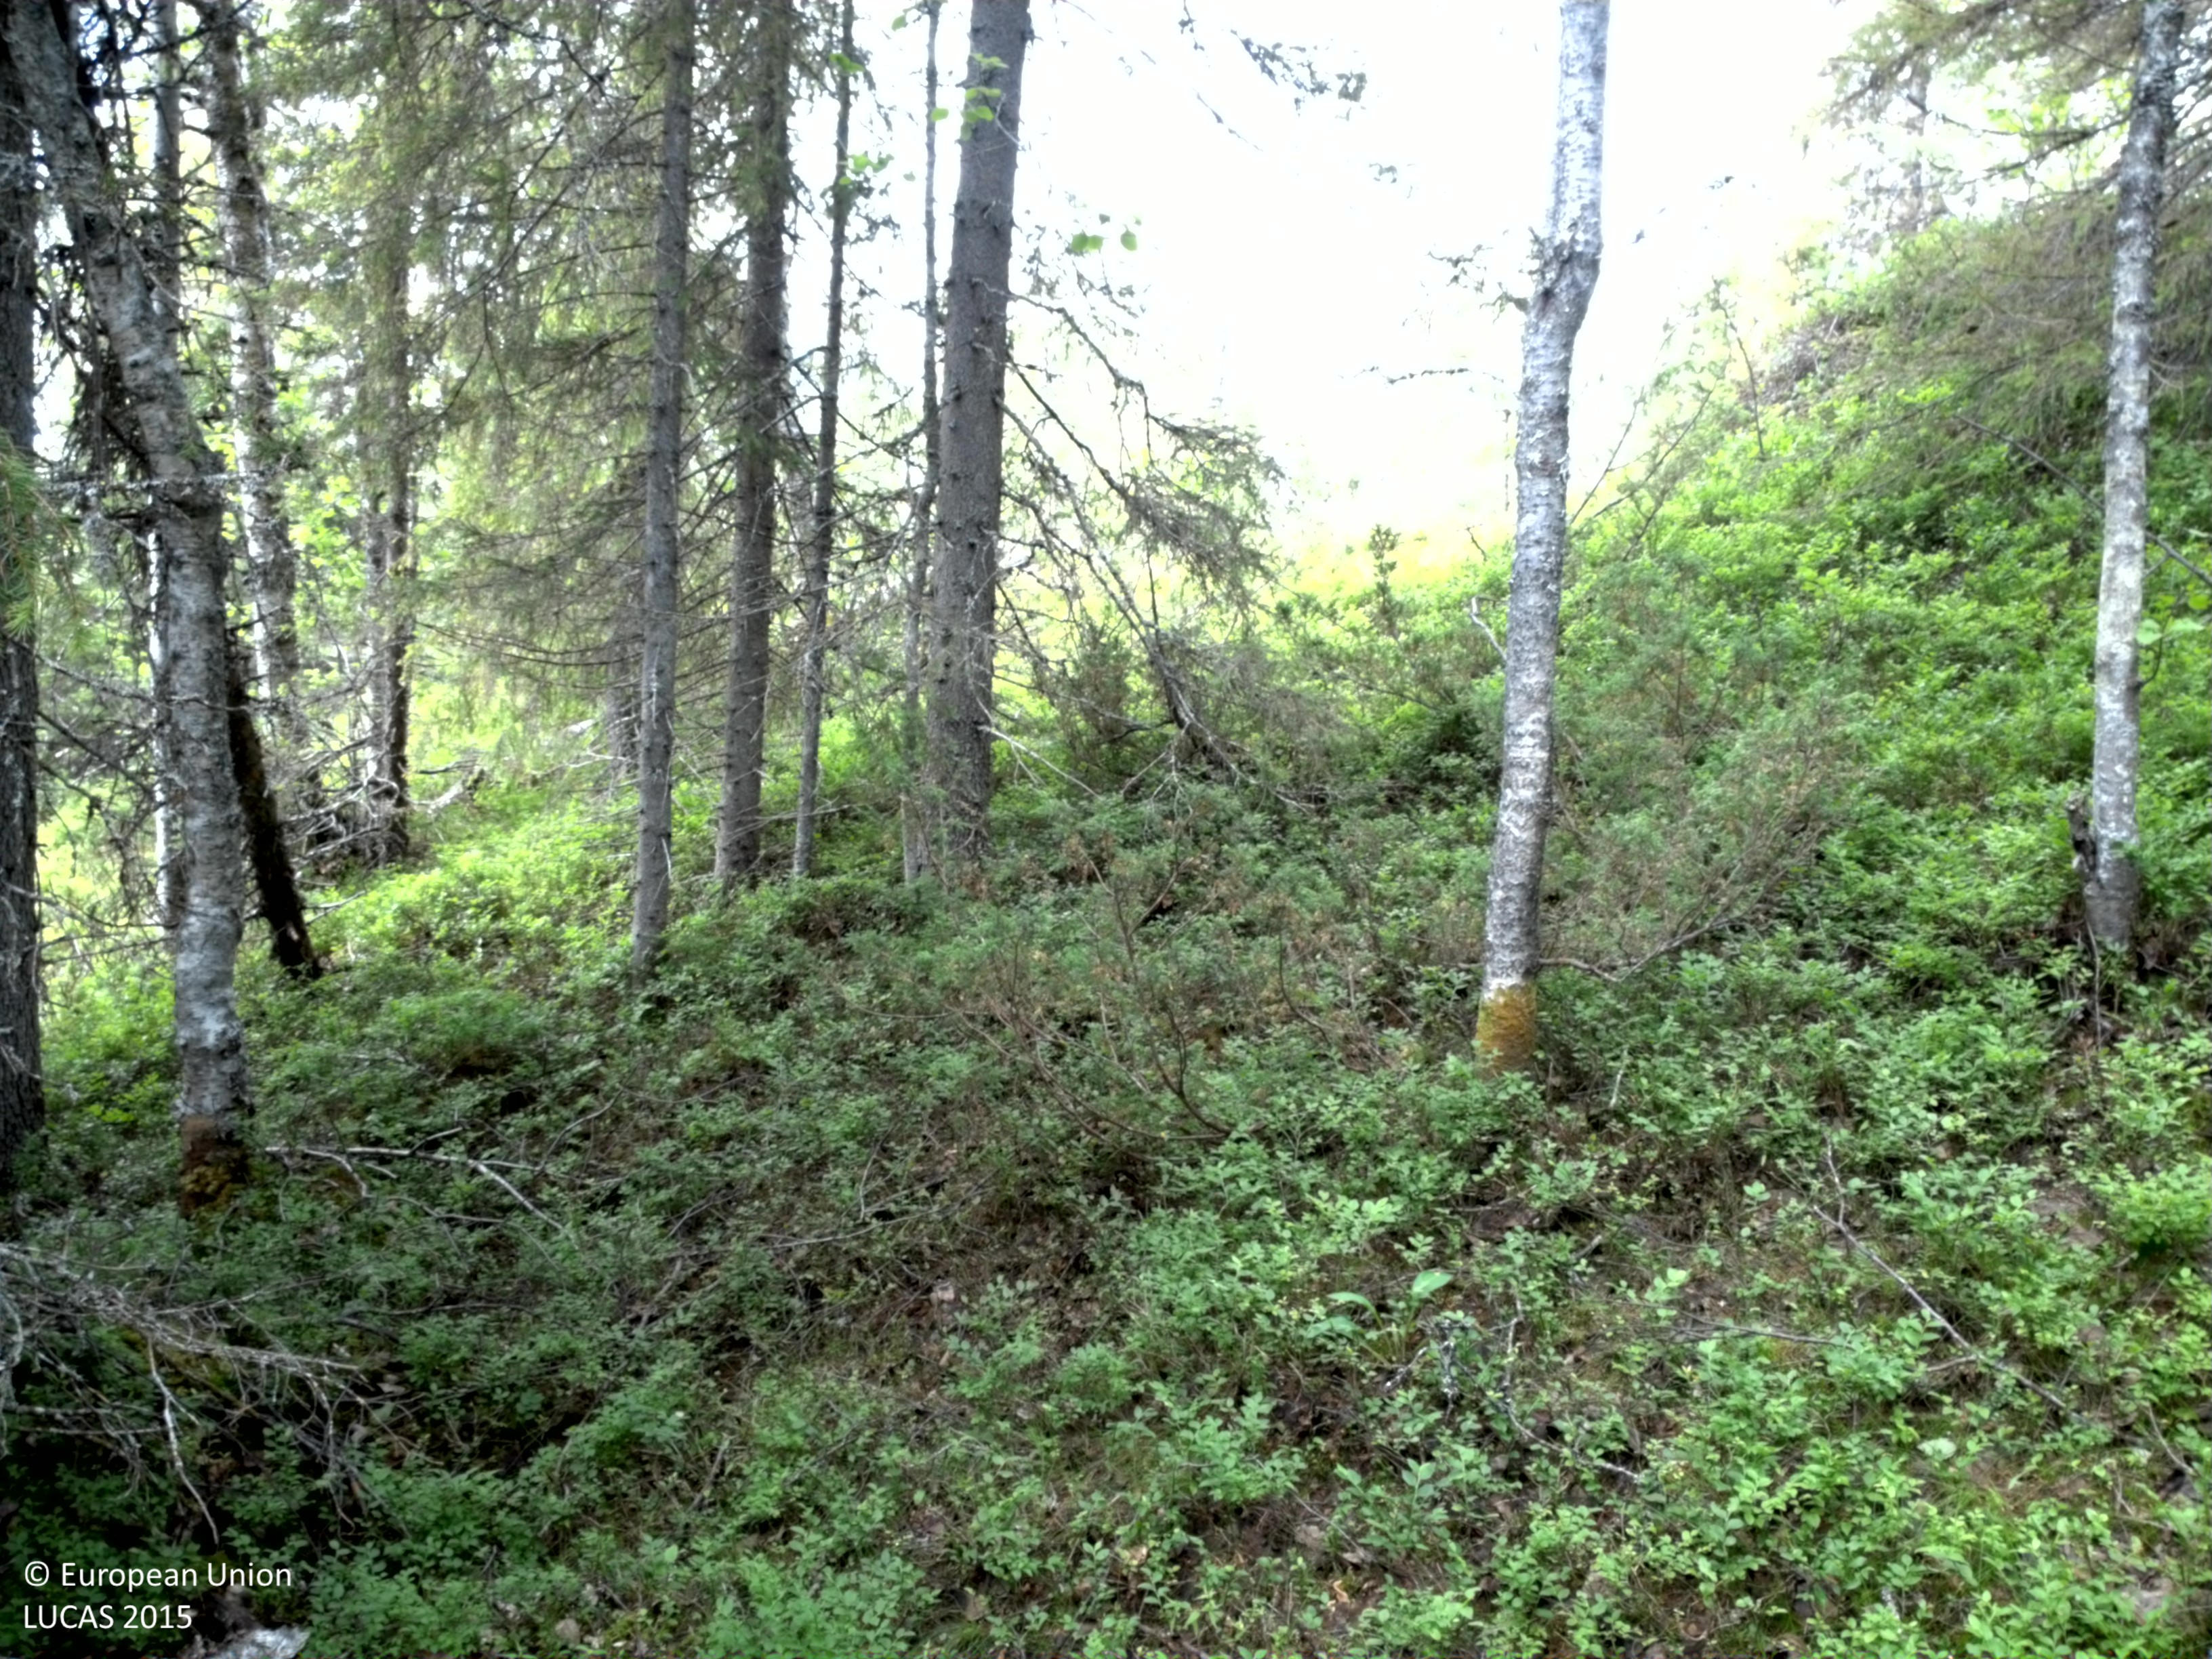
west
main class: Woodland
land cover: Spruce dominated coniferous woodland
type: hemiboreal forest and nemoral coniferous forest and mixed broadleaved-coniferous forest
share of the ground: 25 - 50 %
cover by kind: shrubs 65 %, coniferous forest trees 35 %
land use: Forestry
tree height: > 5 m
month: August
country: SE
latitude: 66.5345
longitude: 20.7822
